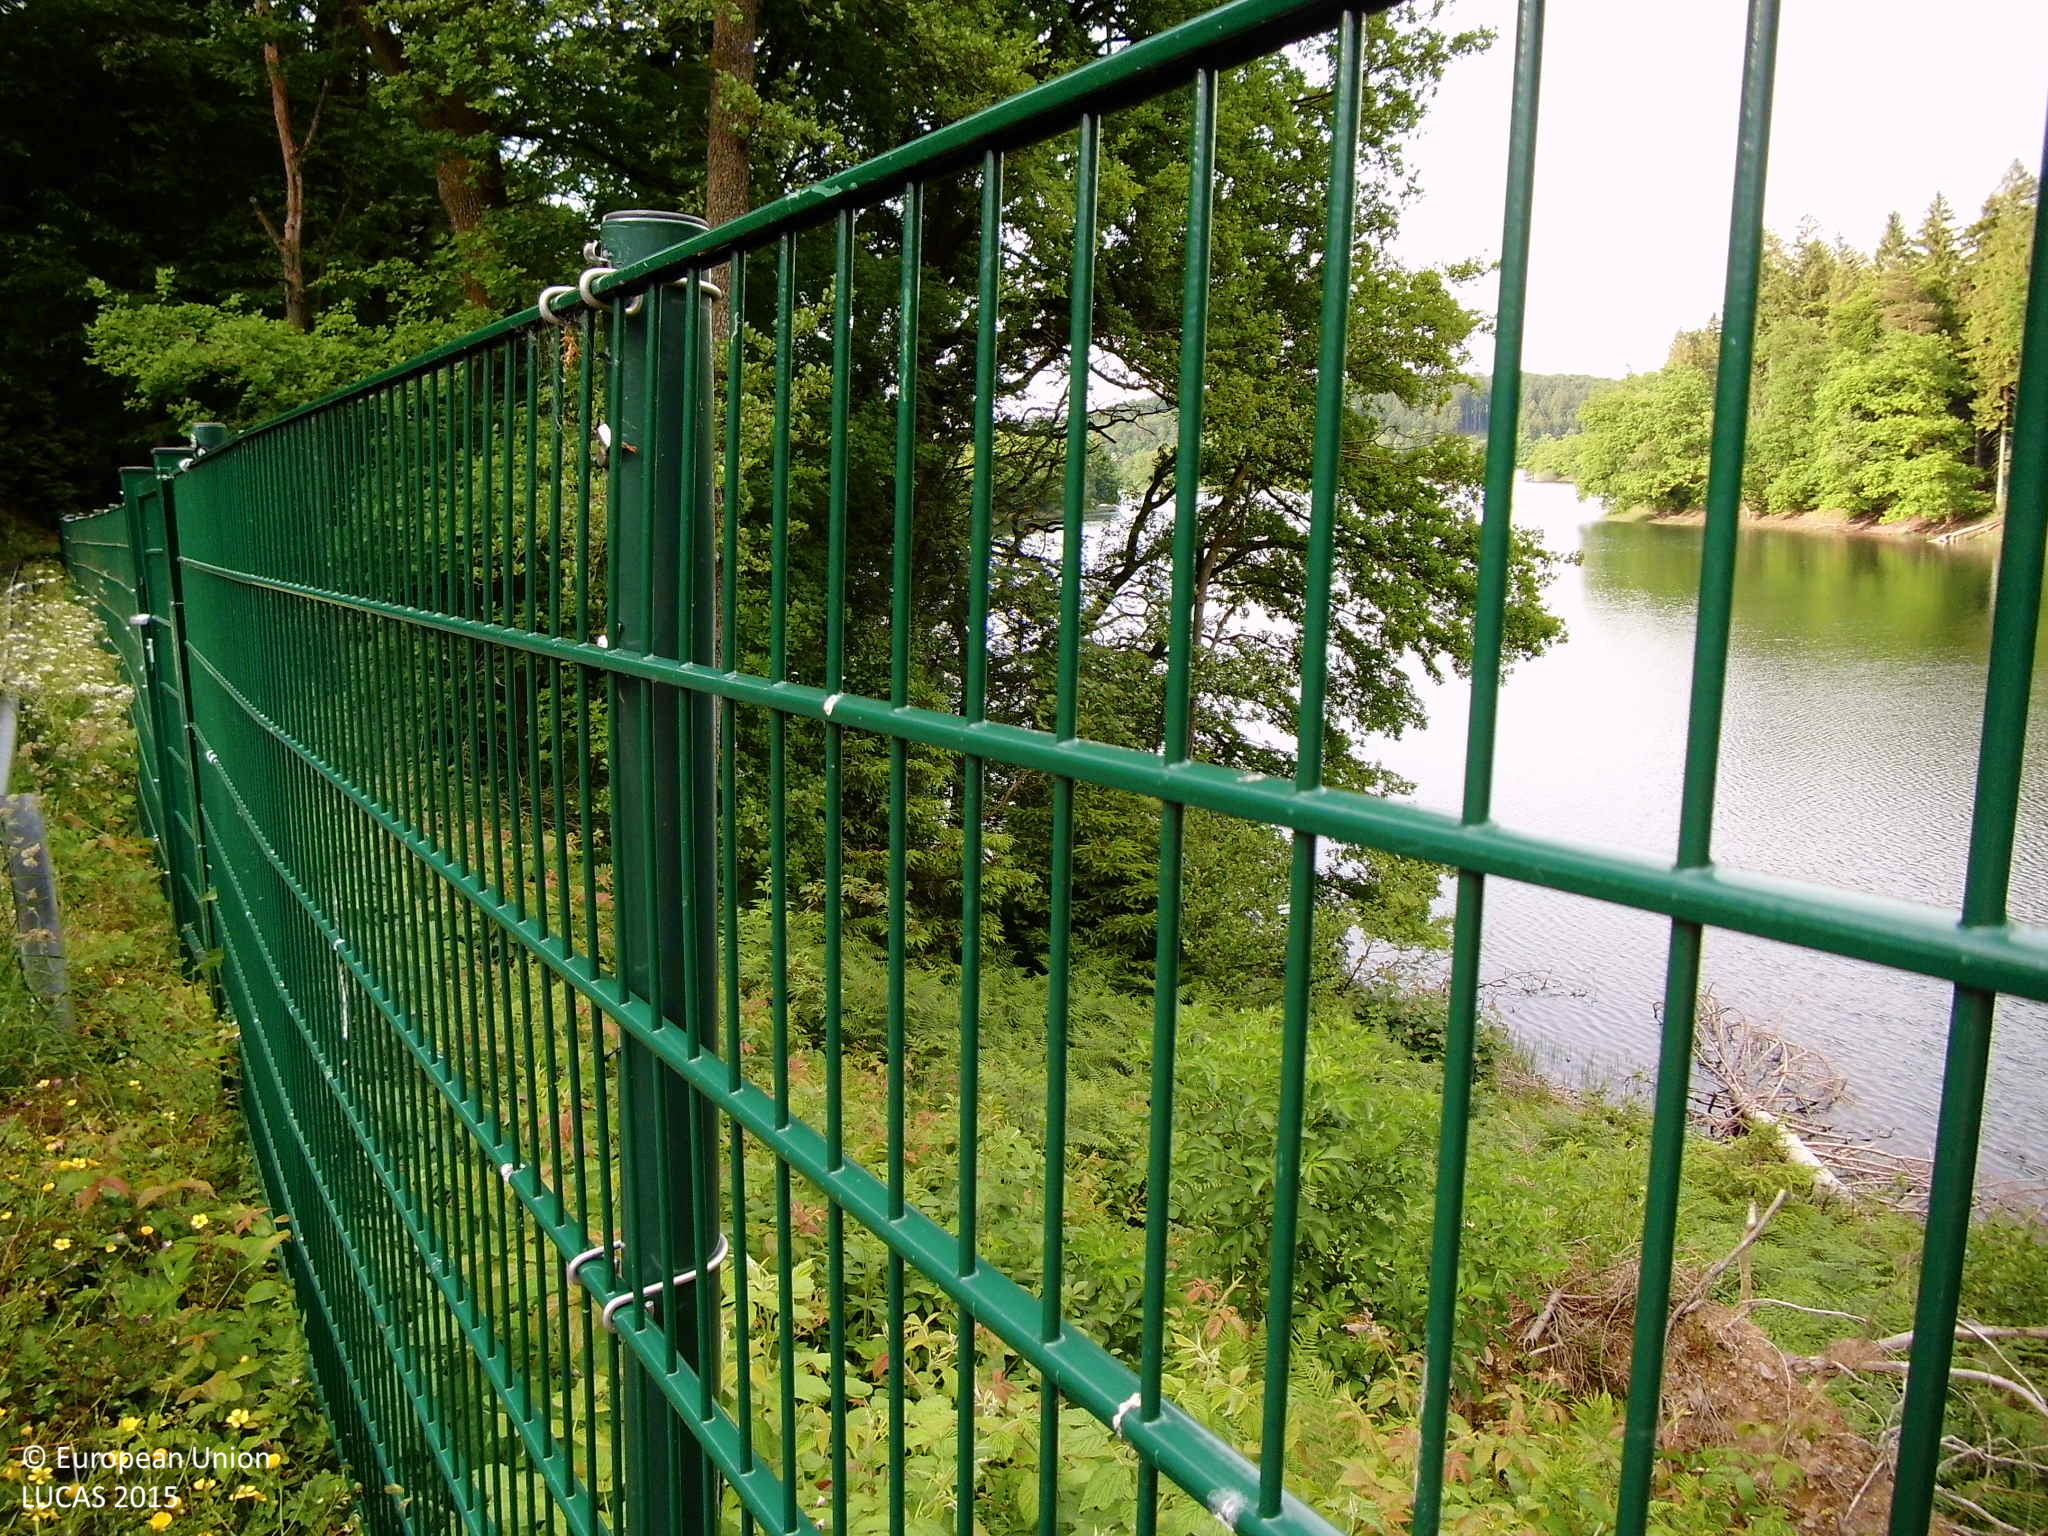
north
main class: Woodland
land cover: Spruce dominated mixed woodland
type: hemiboreal forest and nemoral coniferous forest and mixed broadleaved-coniferous forest
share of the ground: > 75 %
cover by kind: coniferous forest trees 40 %, broadleaved forest trees 35 %, herbaceous plants 10 %, unconsolidated bare surface 10 %, shrubs 5 %
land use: Forestry
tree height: > 5 m
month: June
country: DE
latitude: 51.2341
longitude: 7.4079
